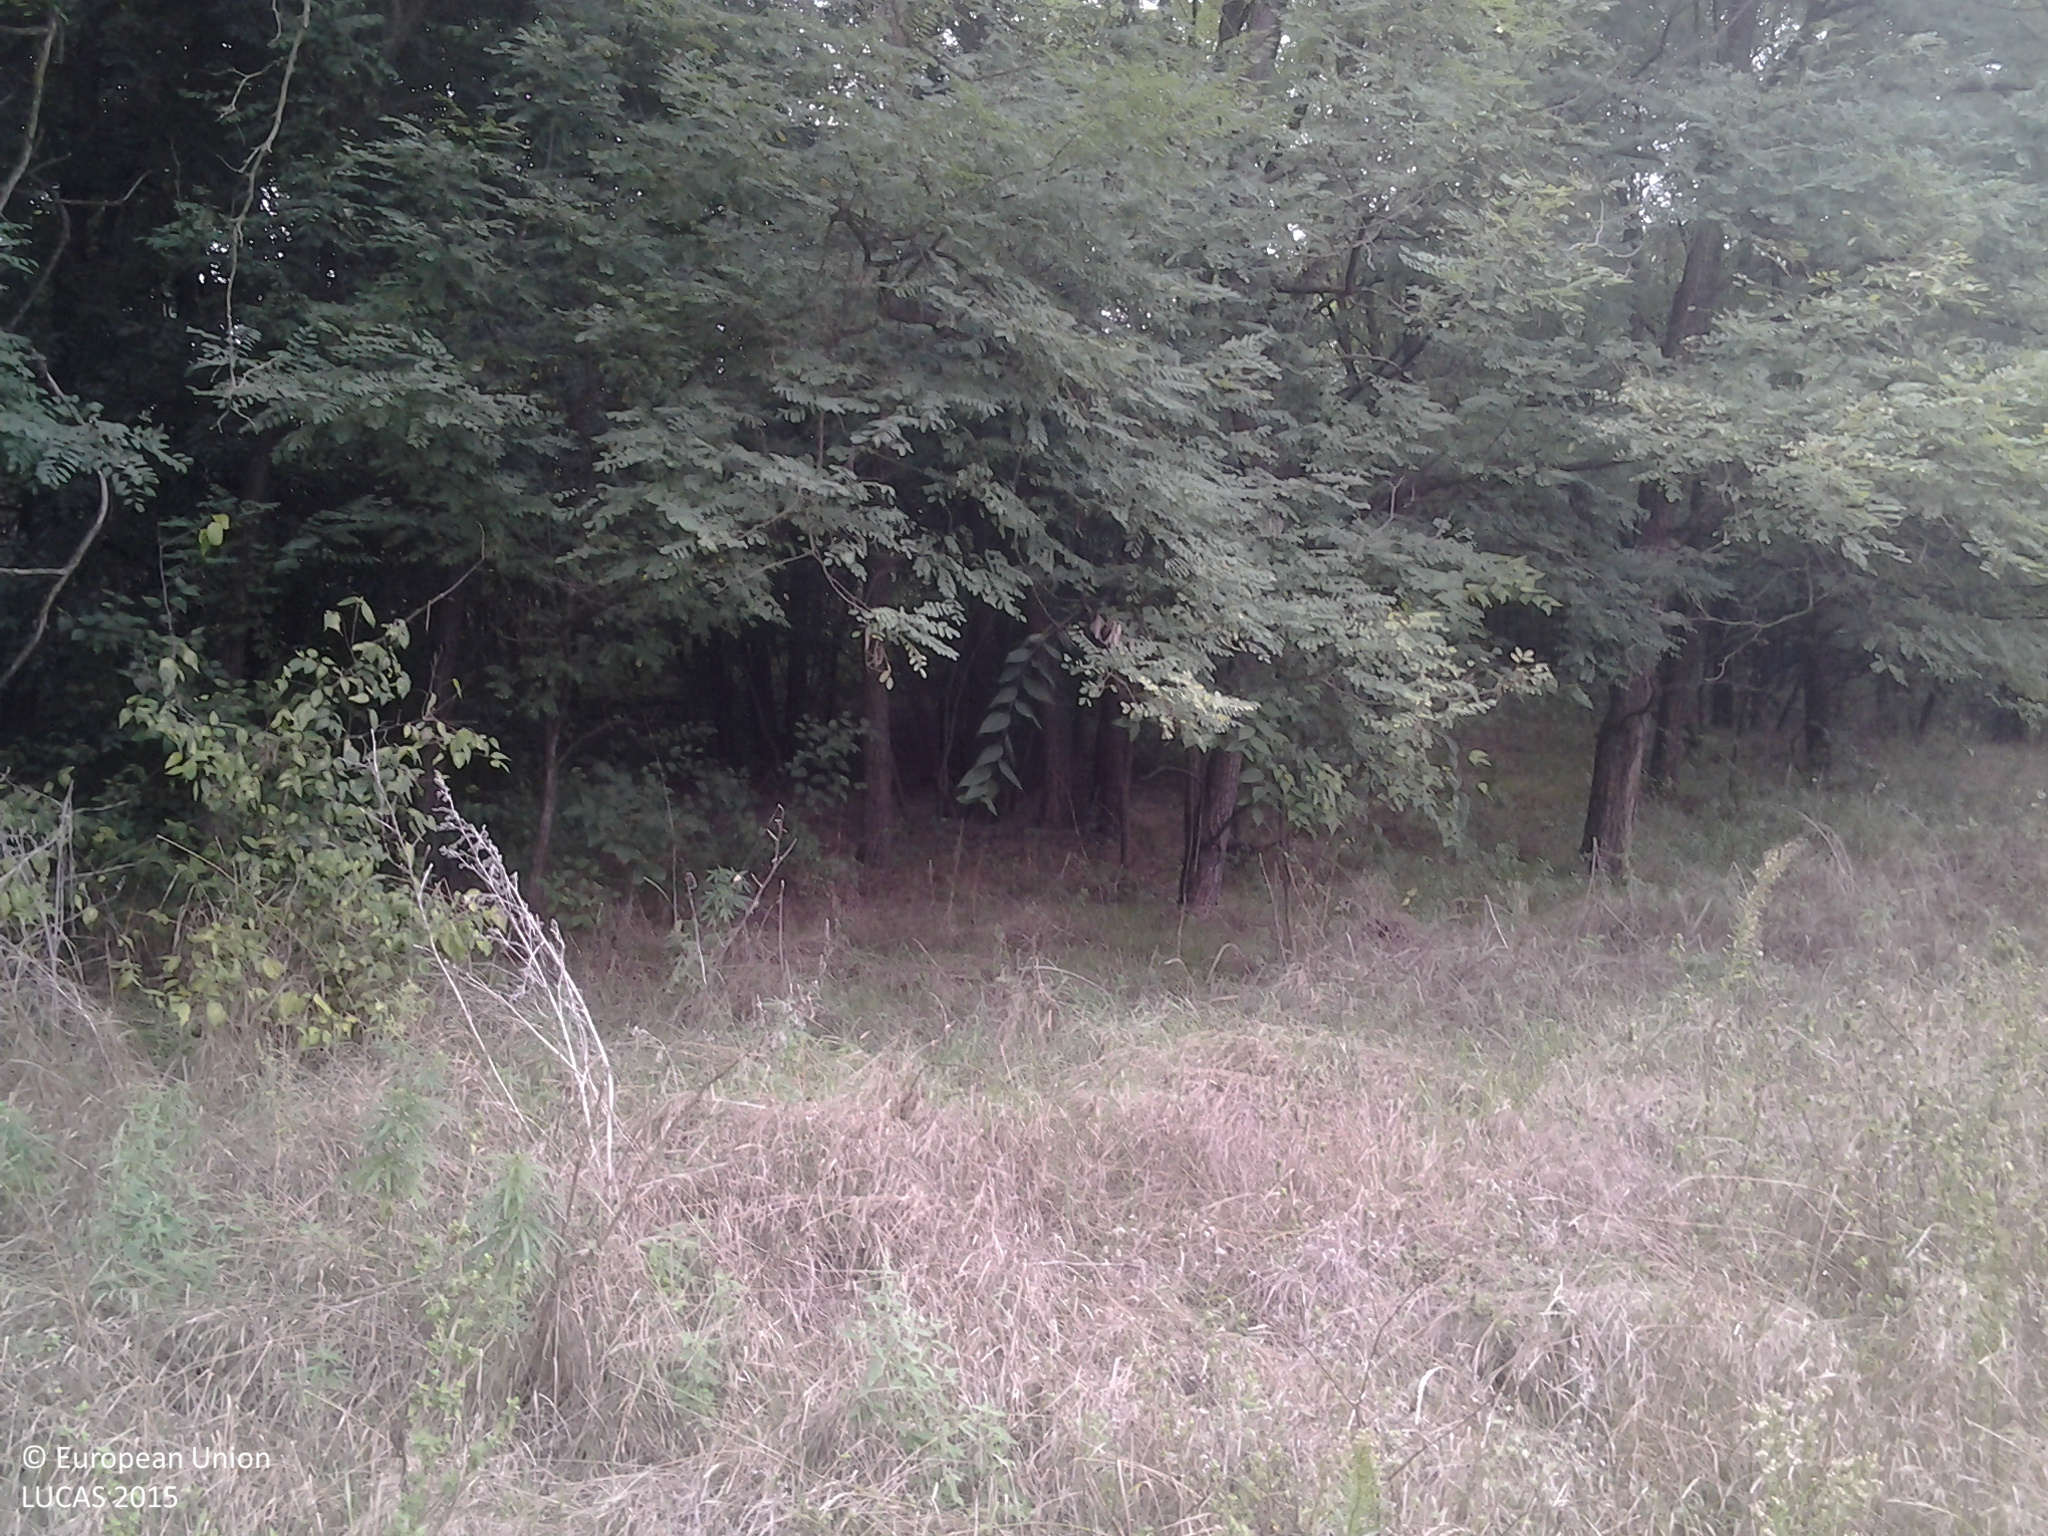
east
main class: Woodland
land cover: Broadleaved woodland
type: mesophytic deciduous forest
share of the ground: > 75 %
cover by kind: broadleaved forest trees 80 %, herbaceous plants 15 %, shrubs 5 %
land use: Forestry
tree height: > 5 m
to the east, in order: Broadleaved woodland; Spruce dominated coniferous woodland; Broadleaved woodland; Tracks; Broadleaved woodland
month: August
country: HU
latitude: 46.0507
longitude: 18.9160
